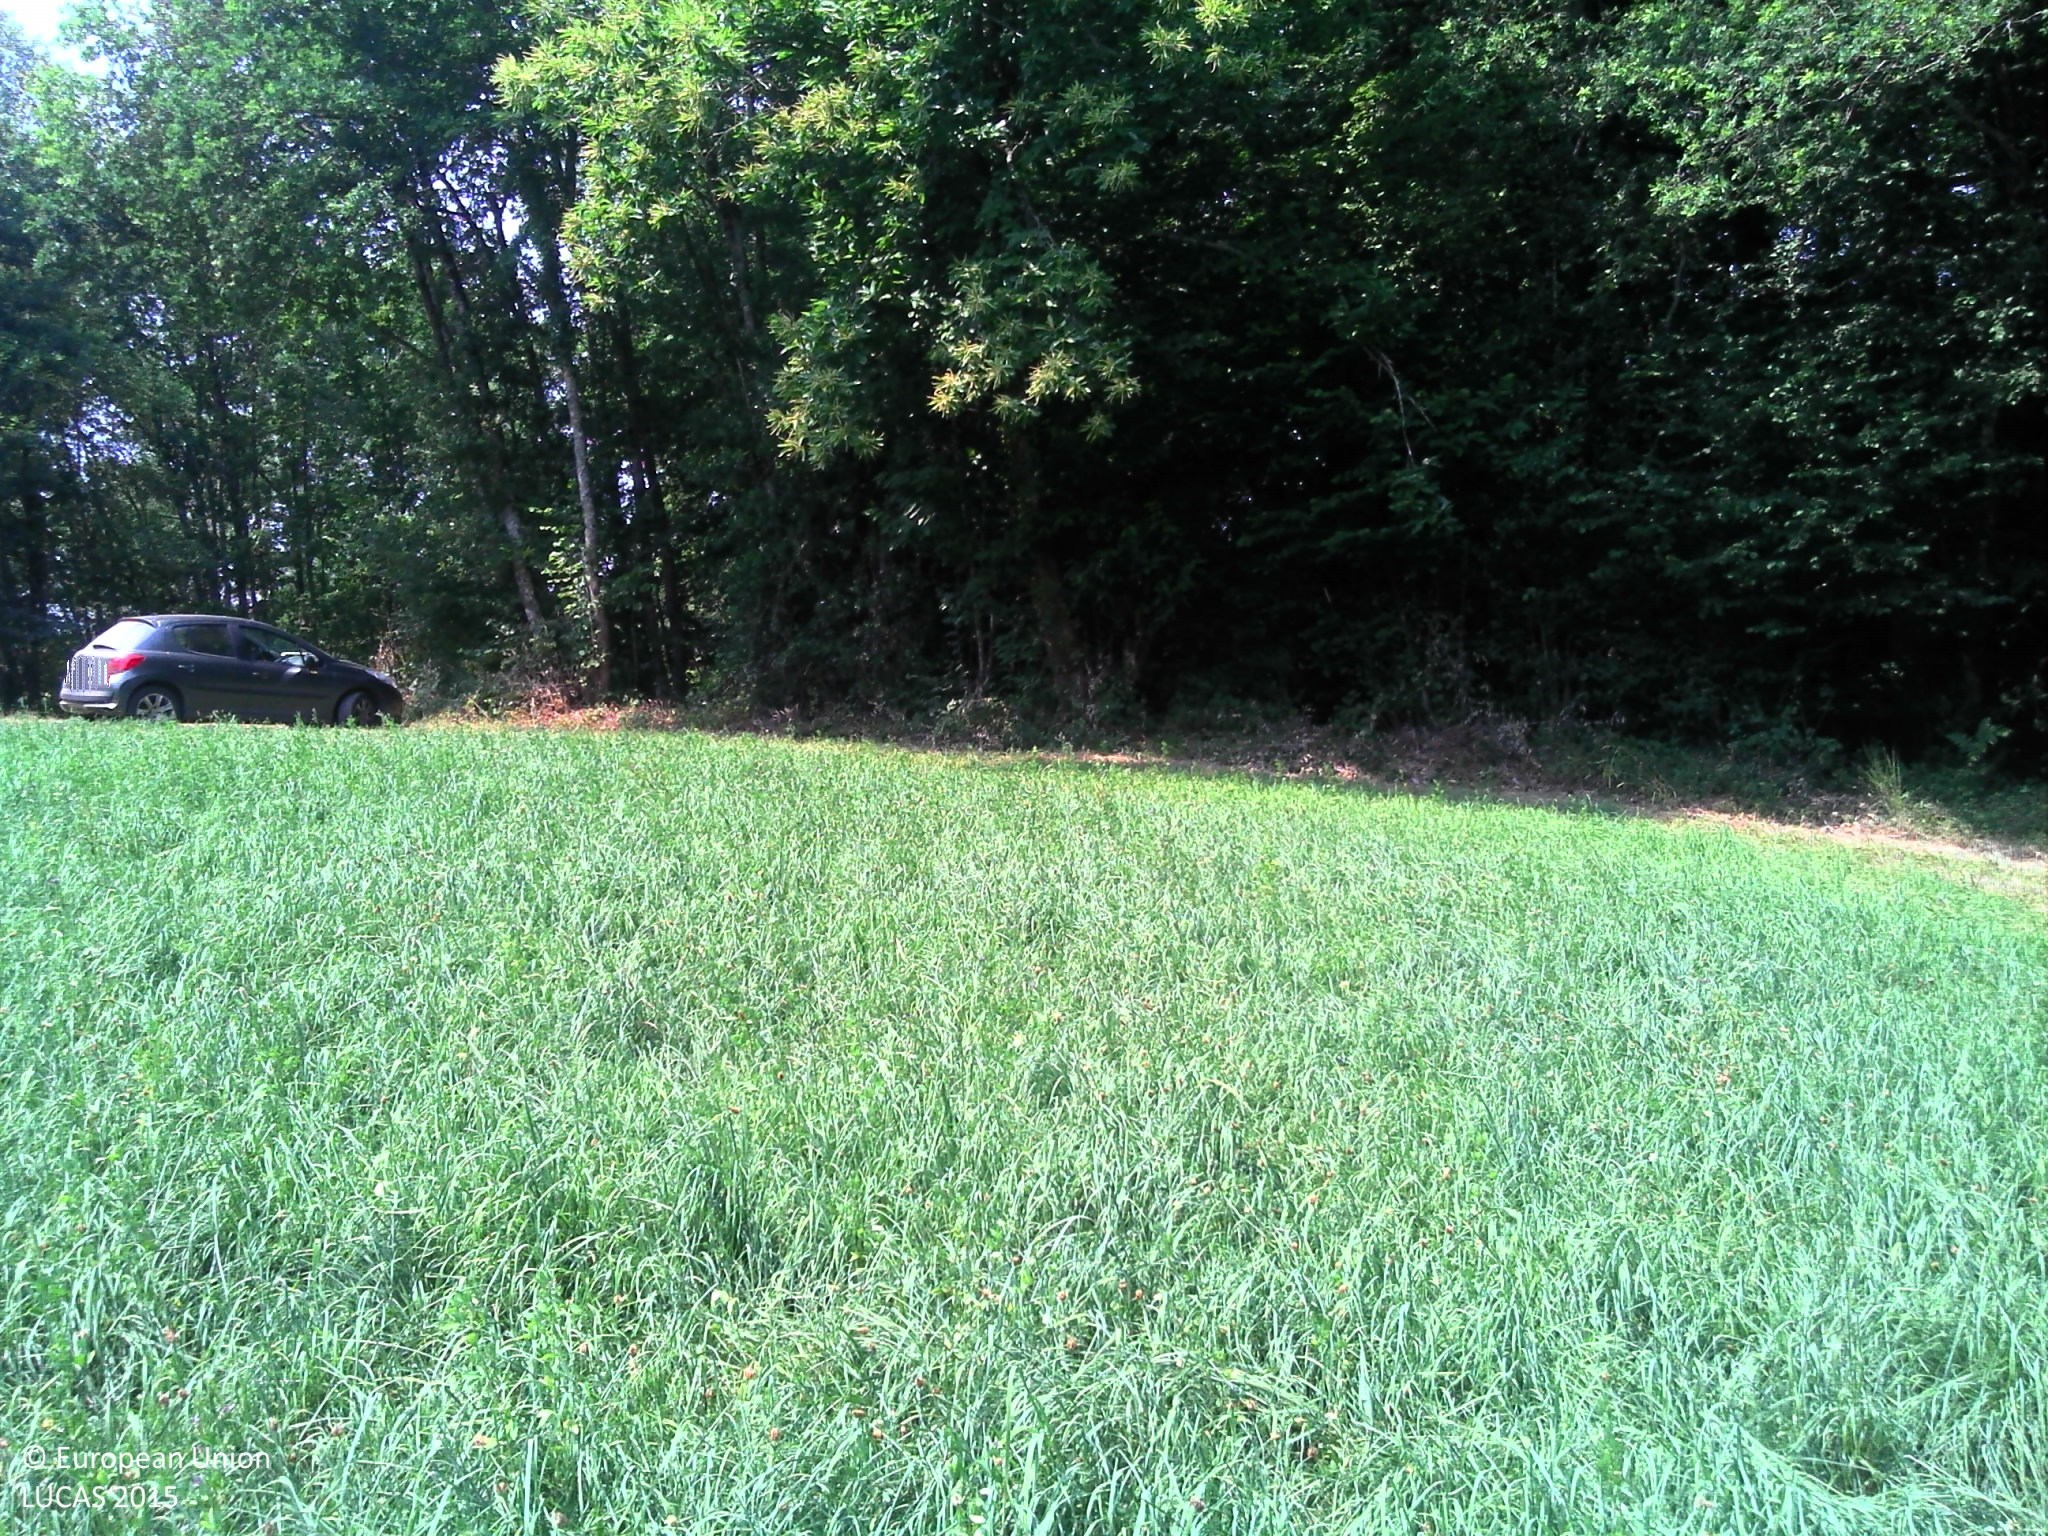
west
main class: Grassland
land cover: Grassland without tree/shrub cover
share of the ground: > 75 %
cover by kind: herbaceous plants 100 %
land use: Agriculture (excluding fallow land and kitchen gardens)
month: July
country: FR
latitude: 46.0172
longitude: 1.7913
